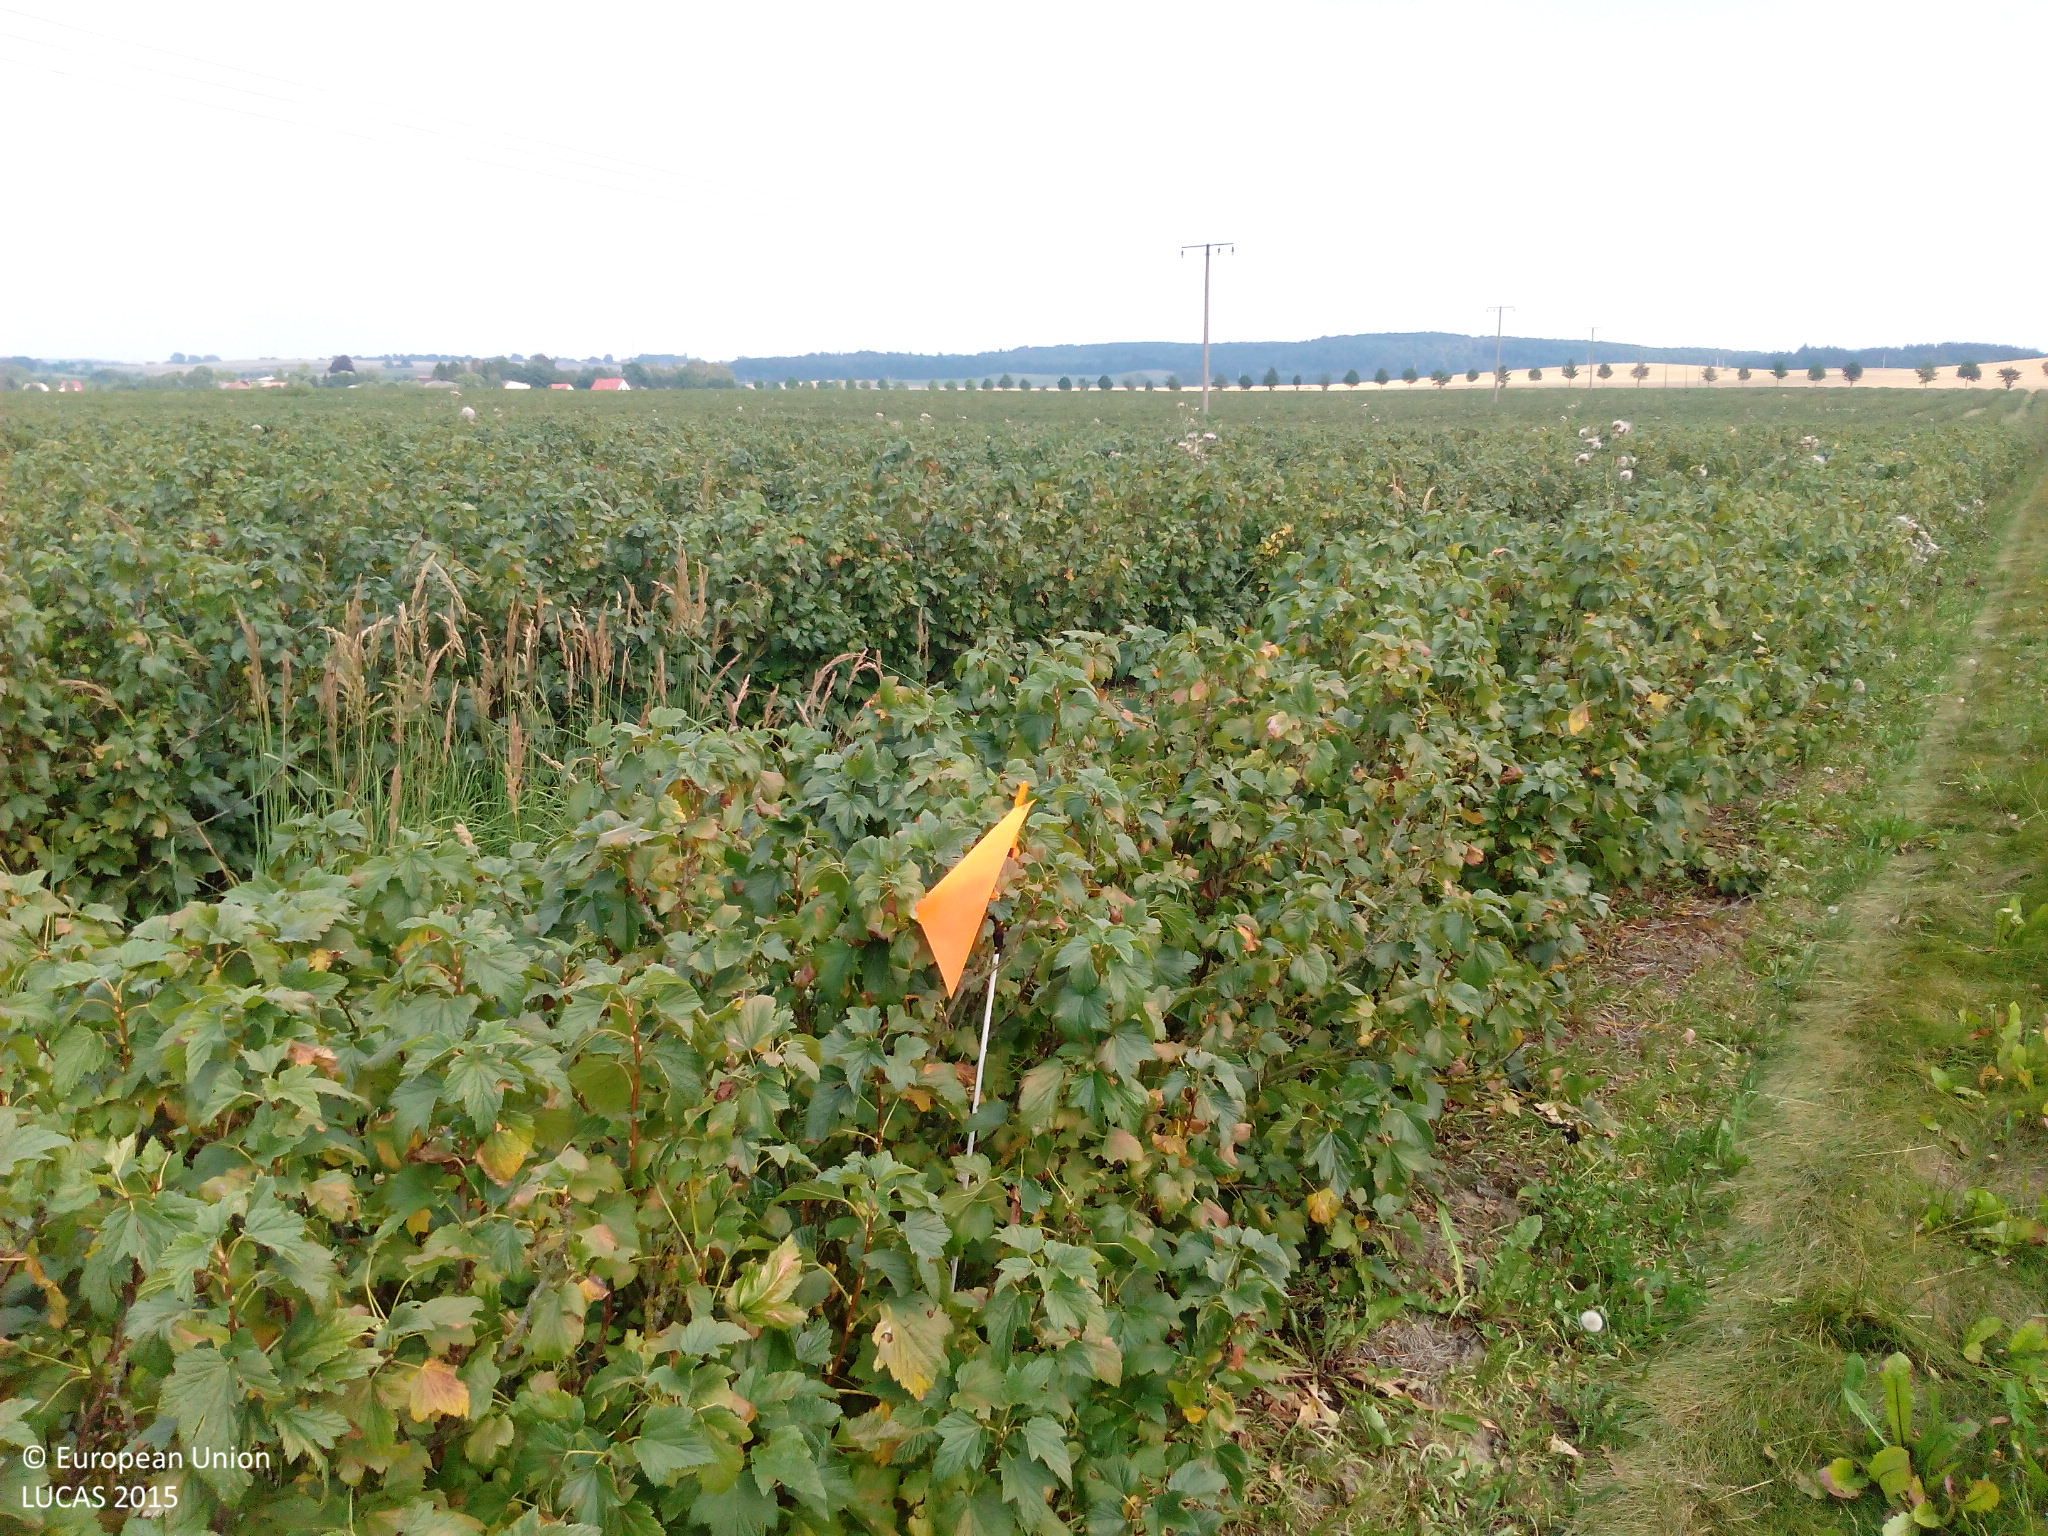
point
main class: Cropland
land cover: Other fruit trees and berries
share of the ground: > 75 %
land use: Agriculture (excluding fallow land and kitchen gardens)
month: August
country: DE
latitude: 53.7518
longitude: 12.5925
